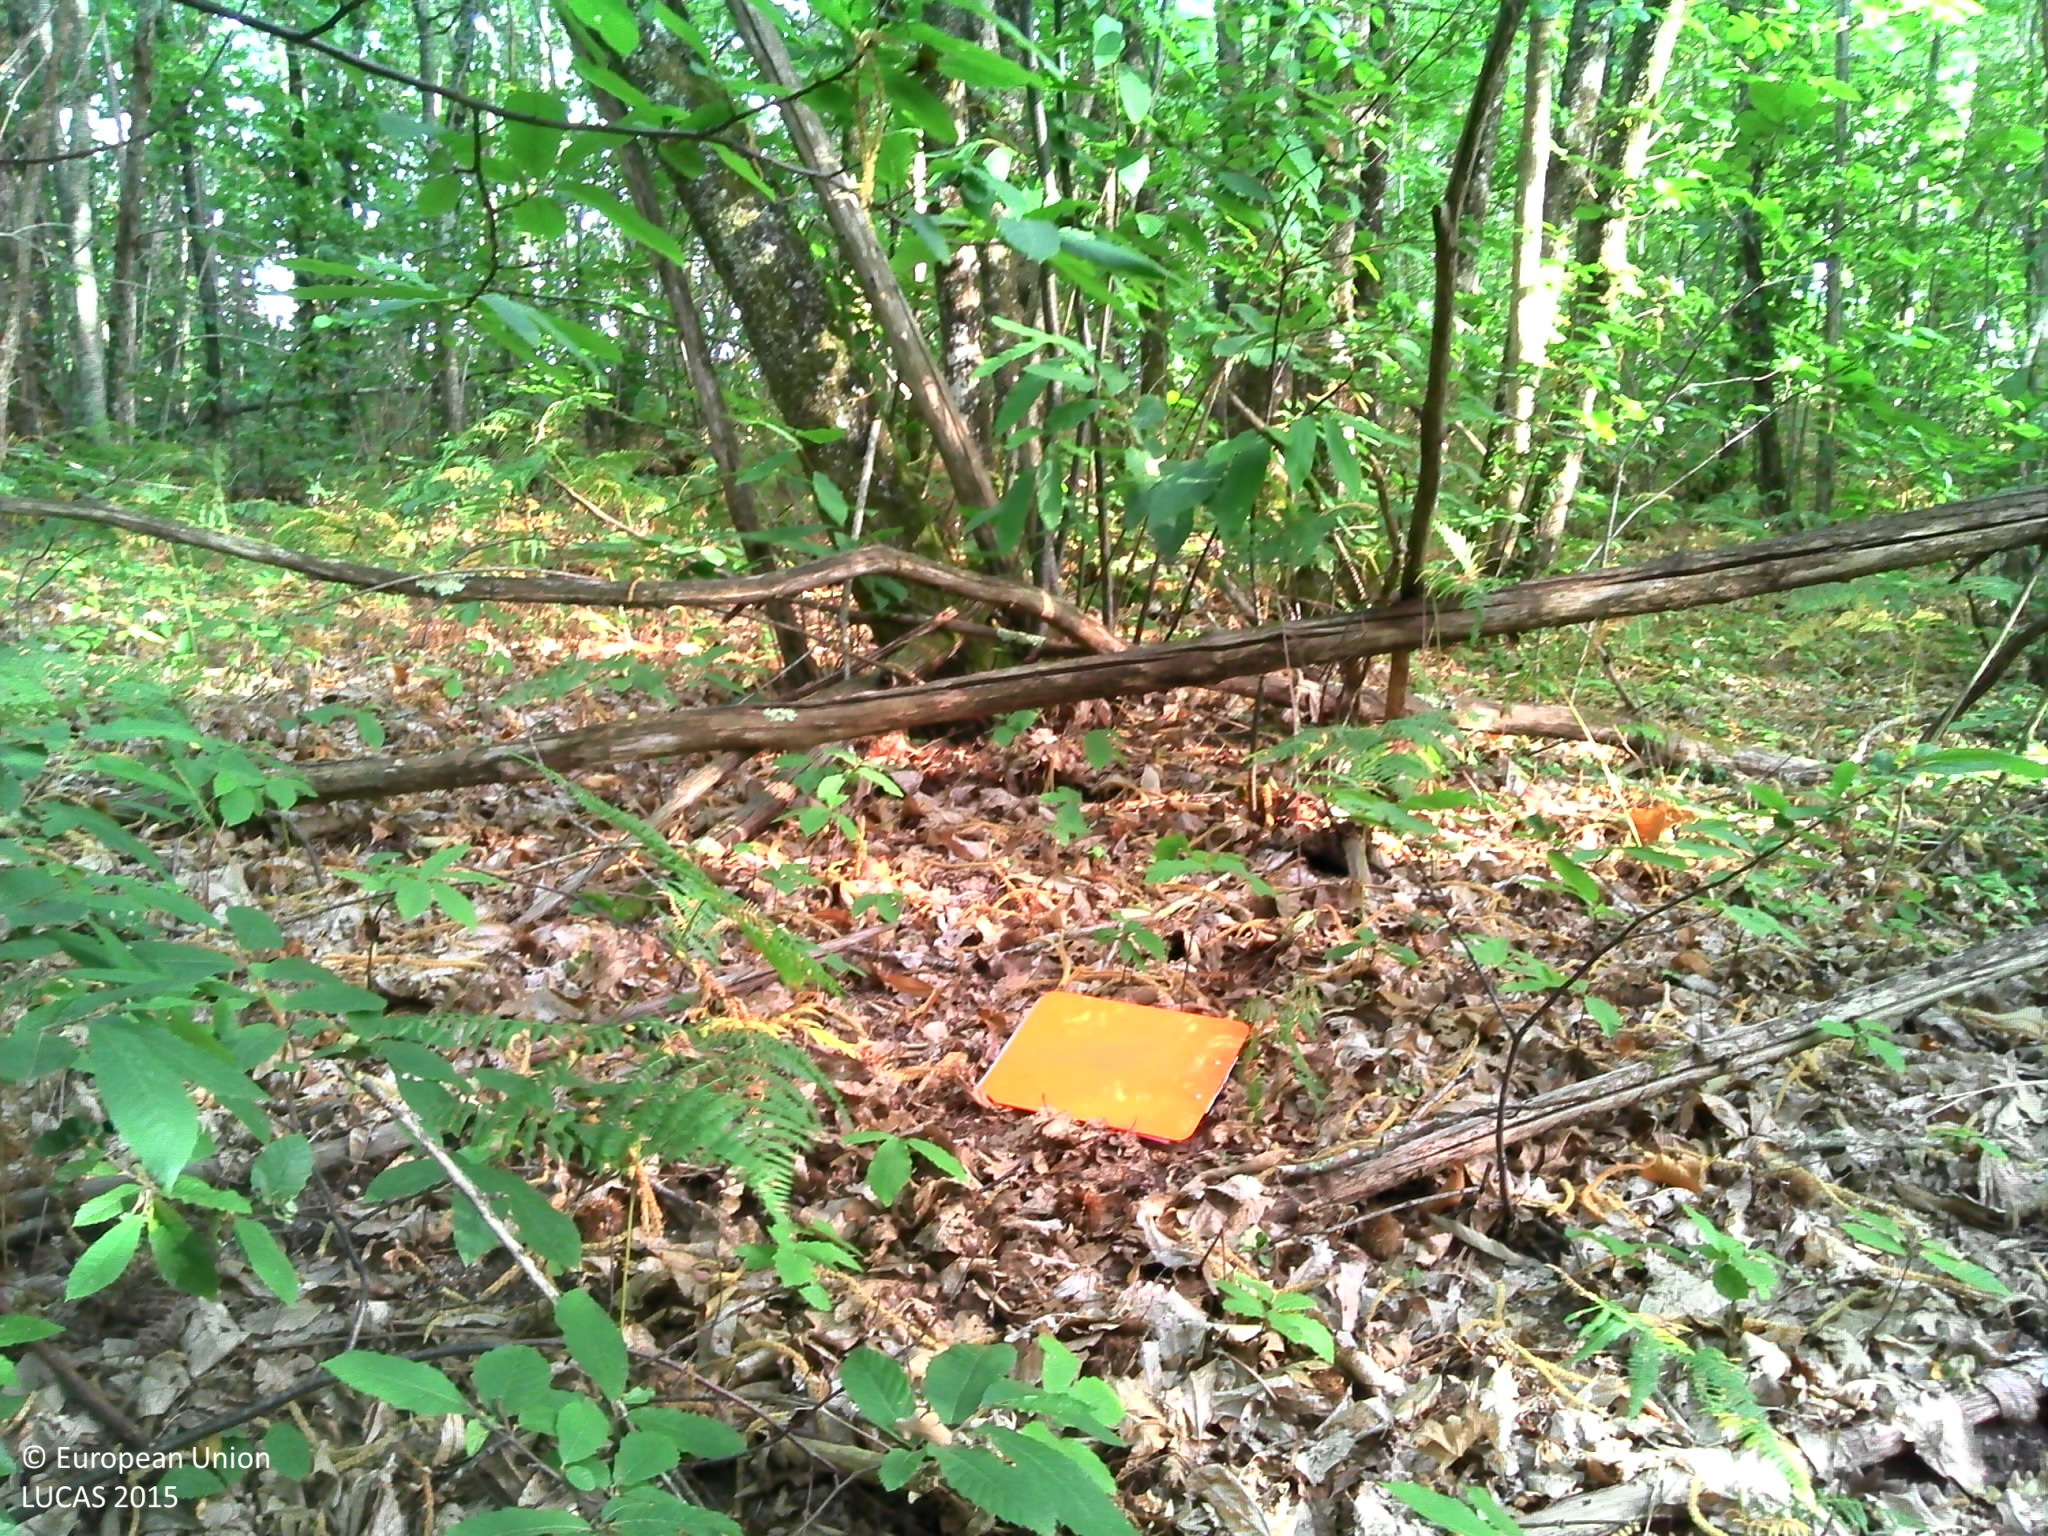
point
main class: Woodland
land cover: Broadleaved woodland
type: thermophilous deciduous forest
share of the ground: > 75 %
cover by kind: broadleaved forest trees 80 %, shrubs 10 %, herbaceous plants 5 %, lichens and mosses 5 %
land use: Forestry
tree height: > 5 m
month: July
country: FR
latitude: 45.0262
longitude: 0.5599
